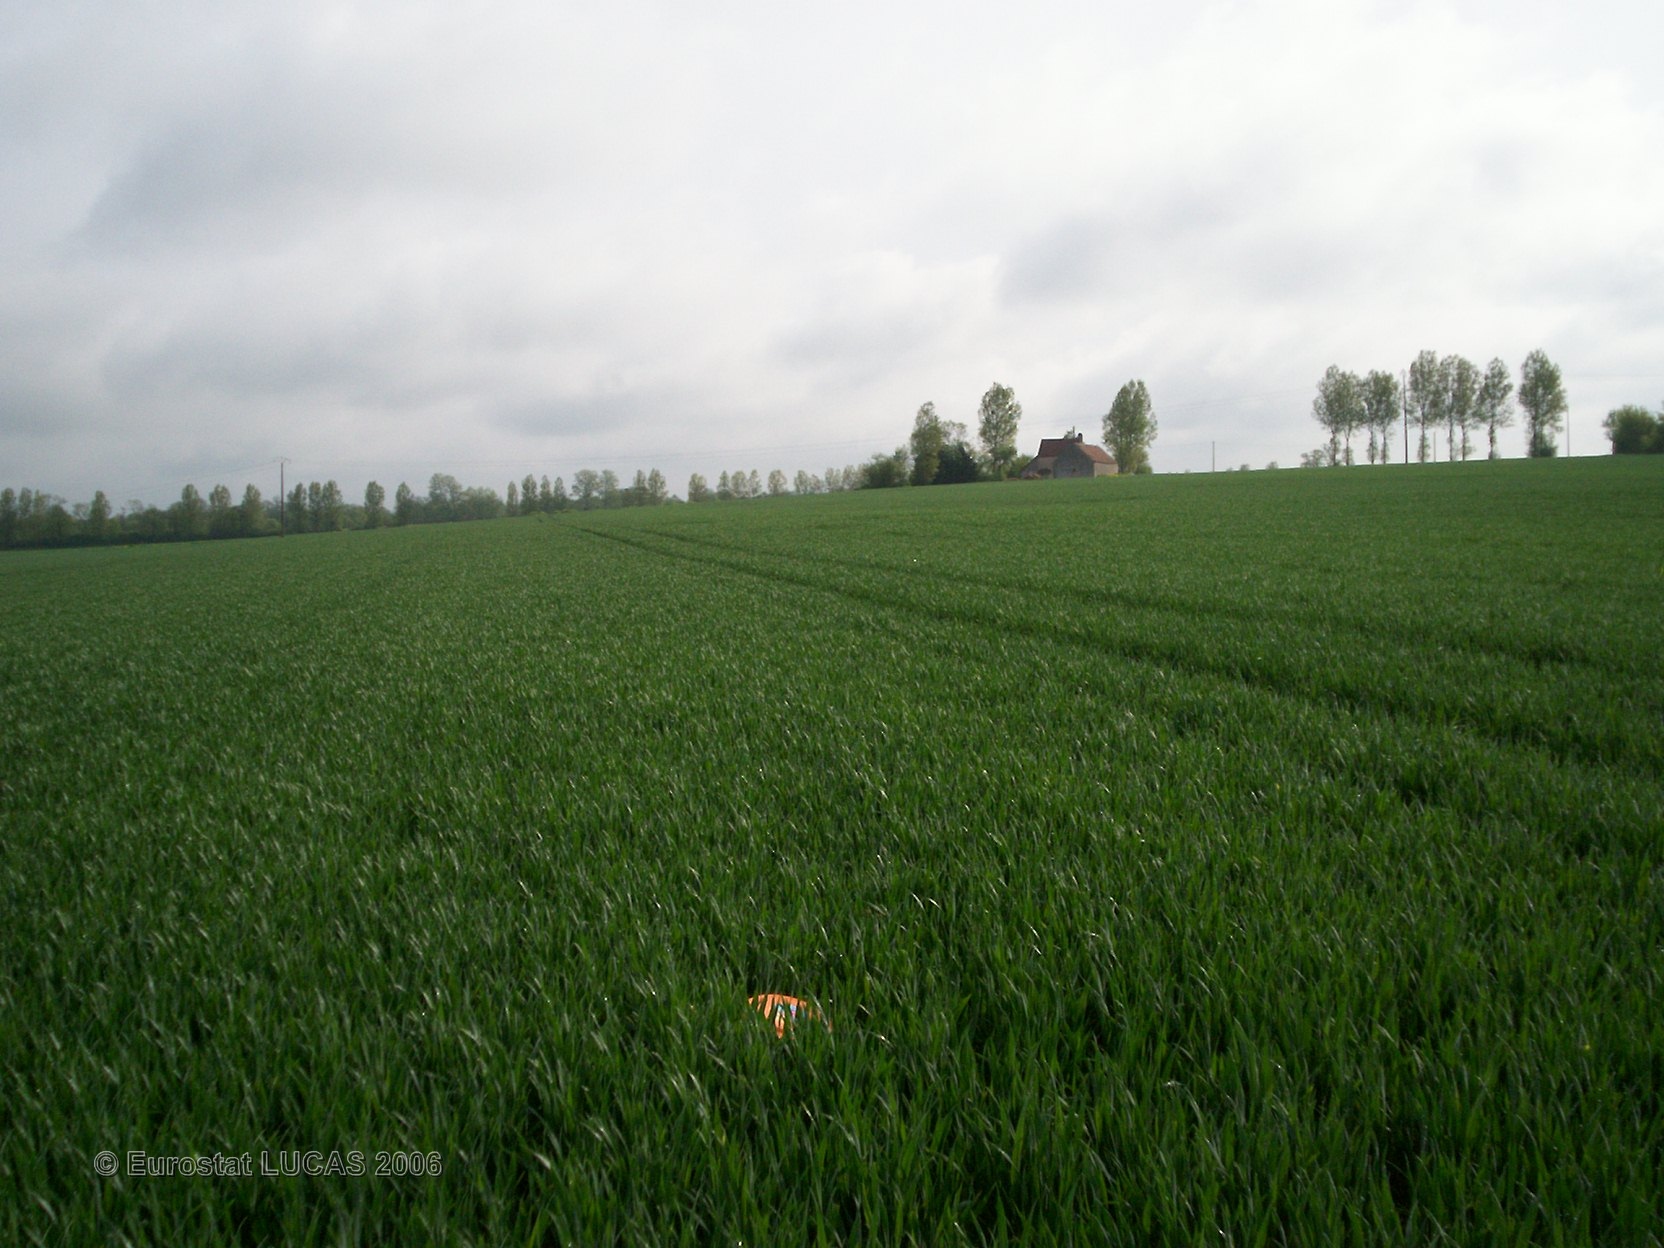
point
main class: Cropland
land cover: Common wheat
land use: Agriculture (excluding fallow land and kitchen gardens)
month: May
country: FR
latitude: 48.6260
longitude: 0.2721
